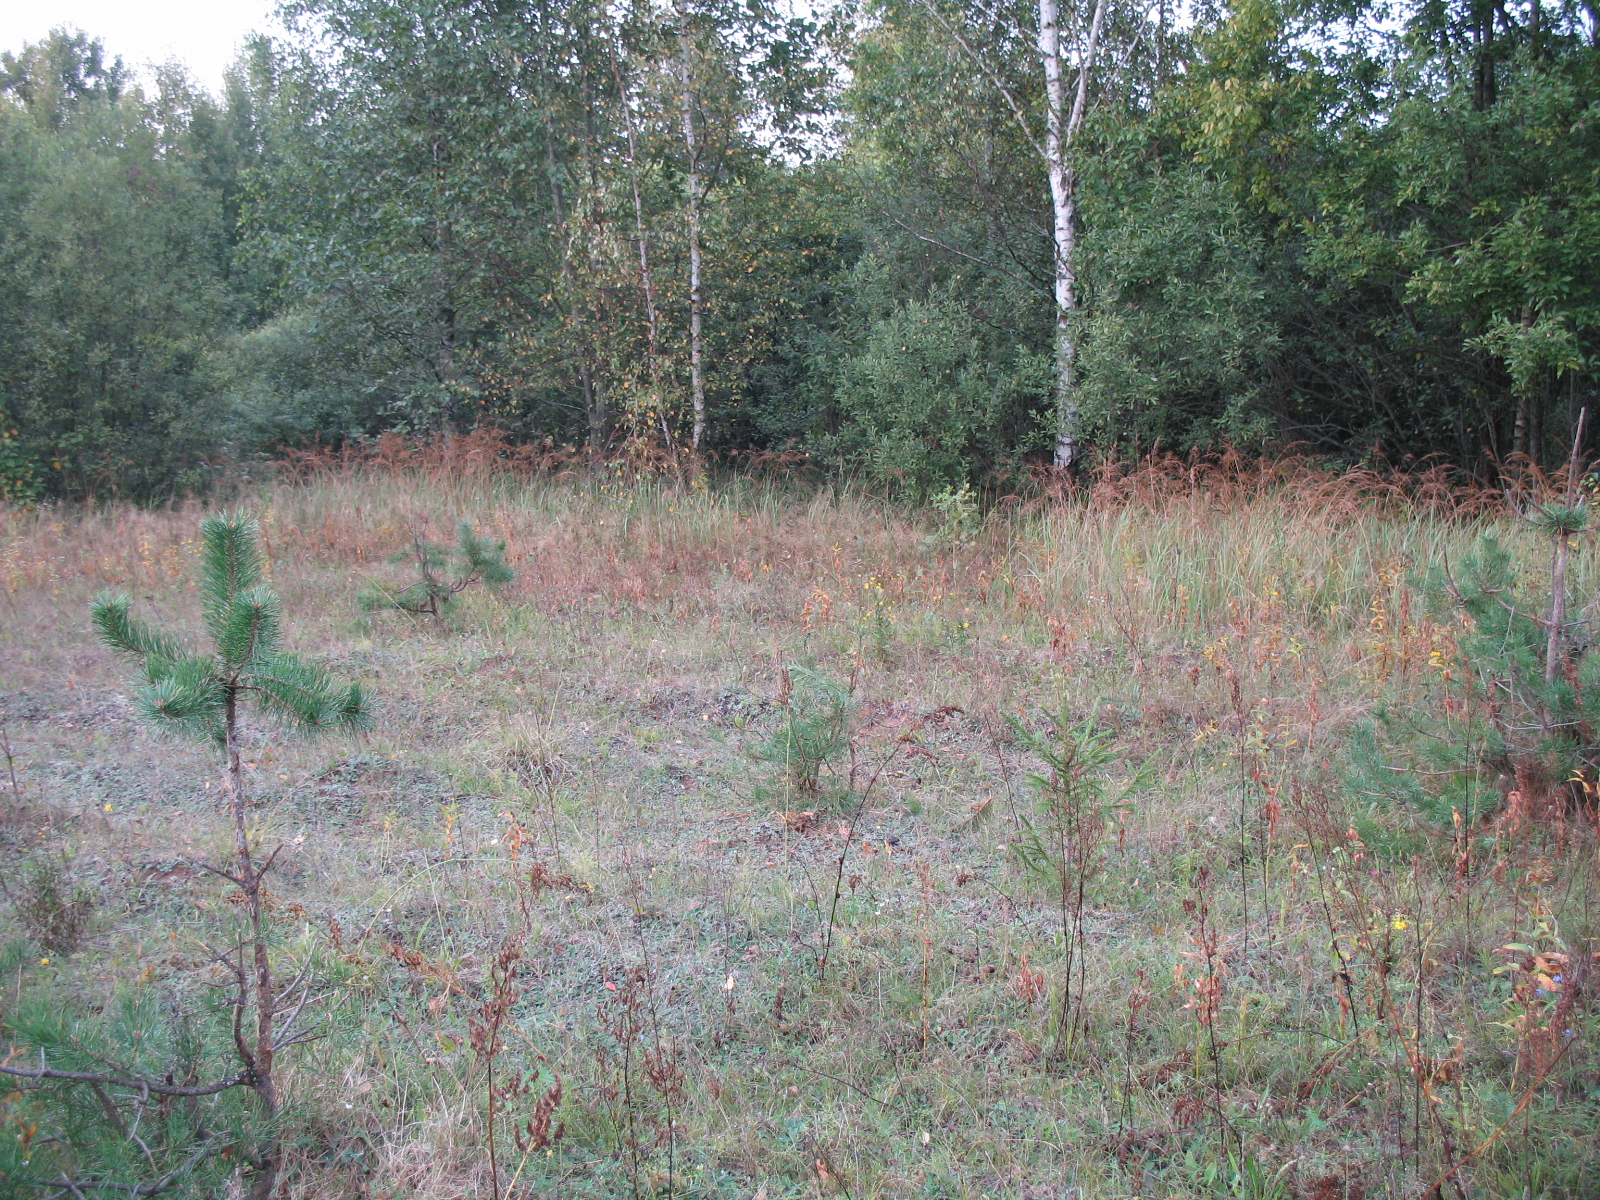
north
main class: Grassland
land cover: Grassland with sparse tree/shrub cover
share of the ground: > 75 %
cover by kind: herbaceous plants 95 %, coniferous forest trees 5 %
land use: Forestry
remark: Nursery
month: September
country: LV
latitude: 56.1520
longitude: 26.2565
